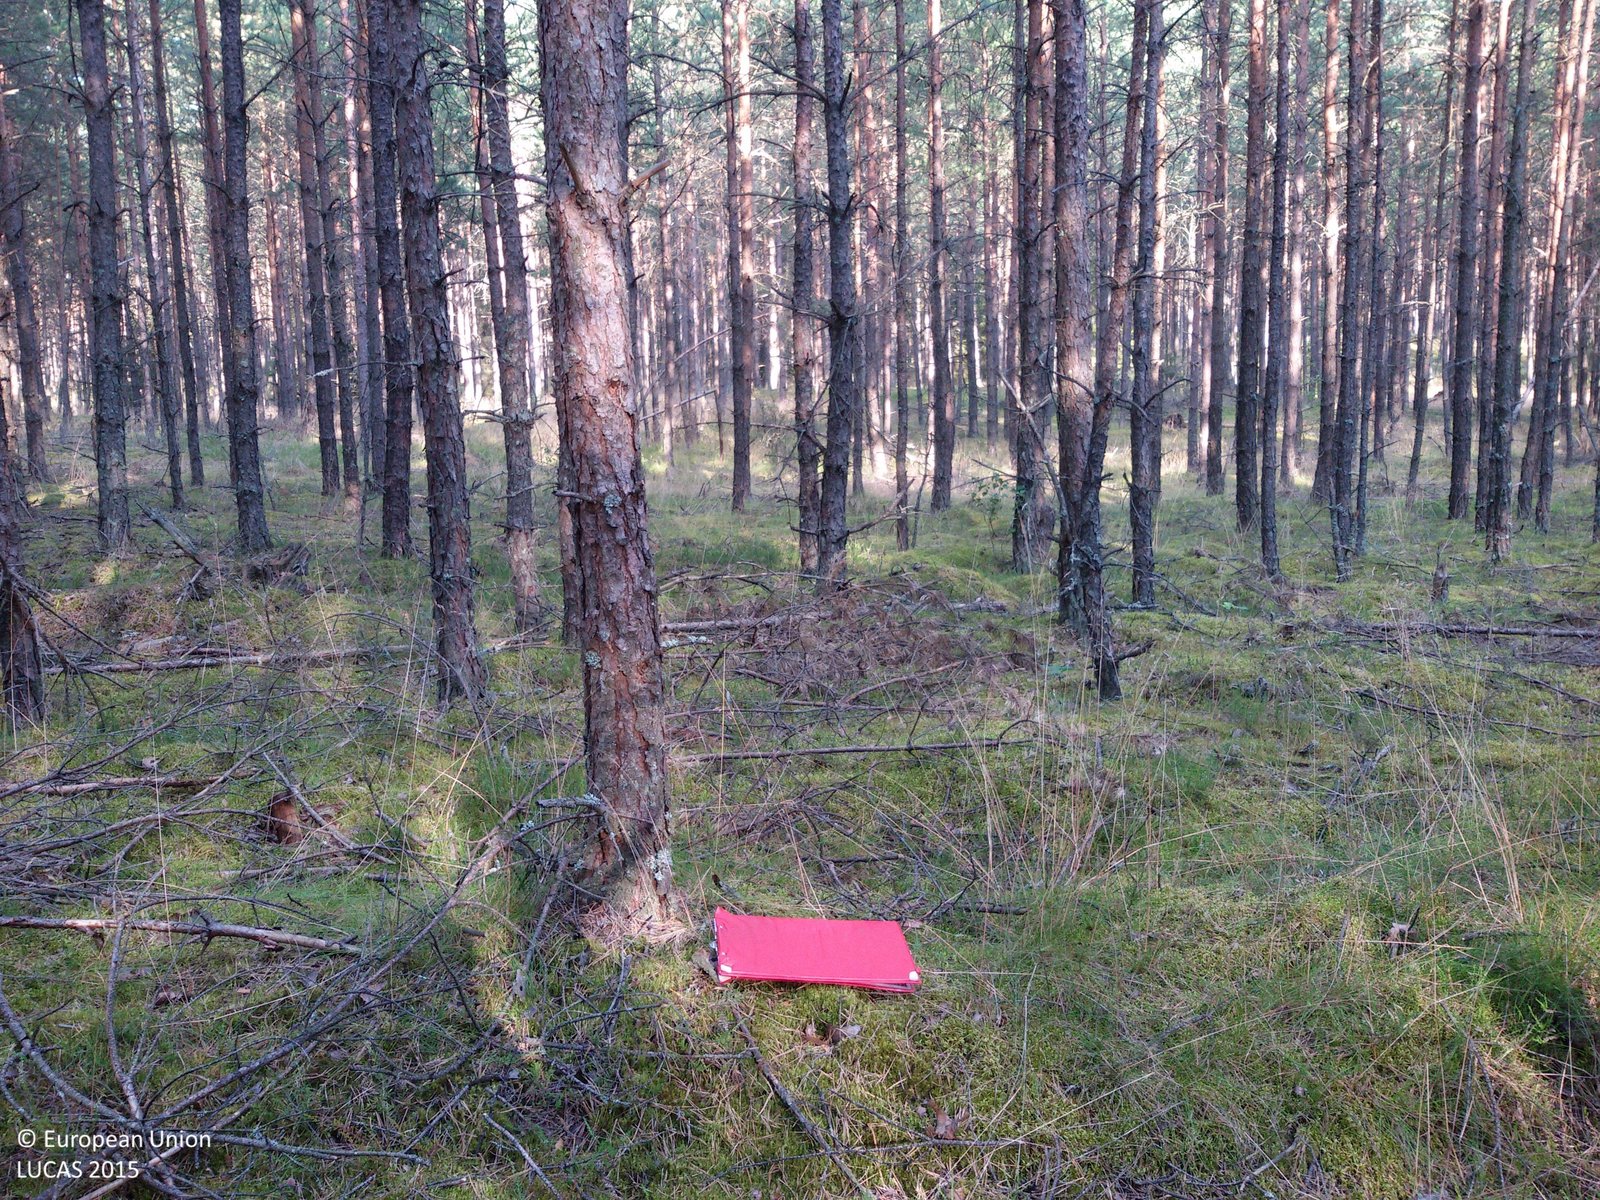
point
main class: Woodland
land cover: Pine dominated coniferous woodland
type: hemiboreal forest and nemoral coniferous forest and mixed broadleaved-coniferous forest
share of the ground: > 75 %
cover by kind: coniferous forest trees 85 %, lichens and mosses 10 %, herbaceous plants 5 %
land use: Forestry
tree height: > 5 m
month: August
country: PL
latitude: 54.1593
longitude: 17.8385
